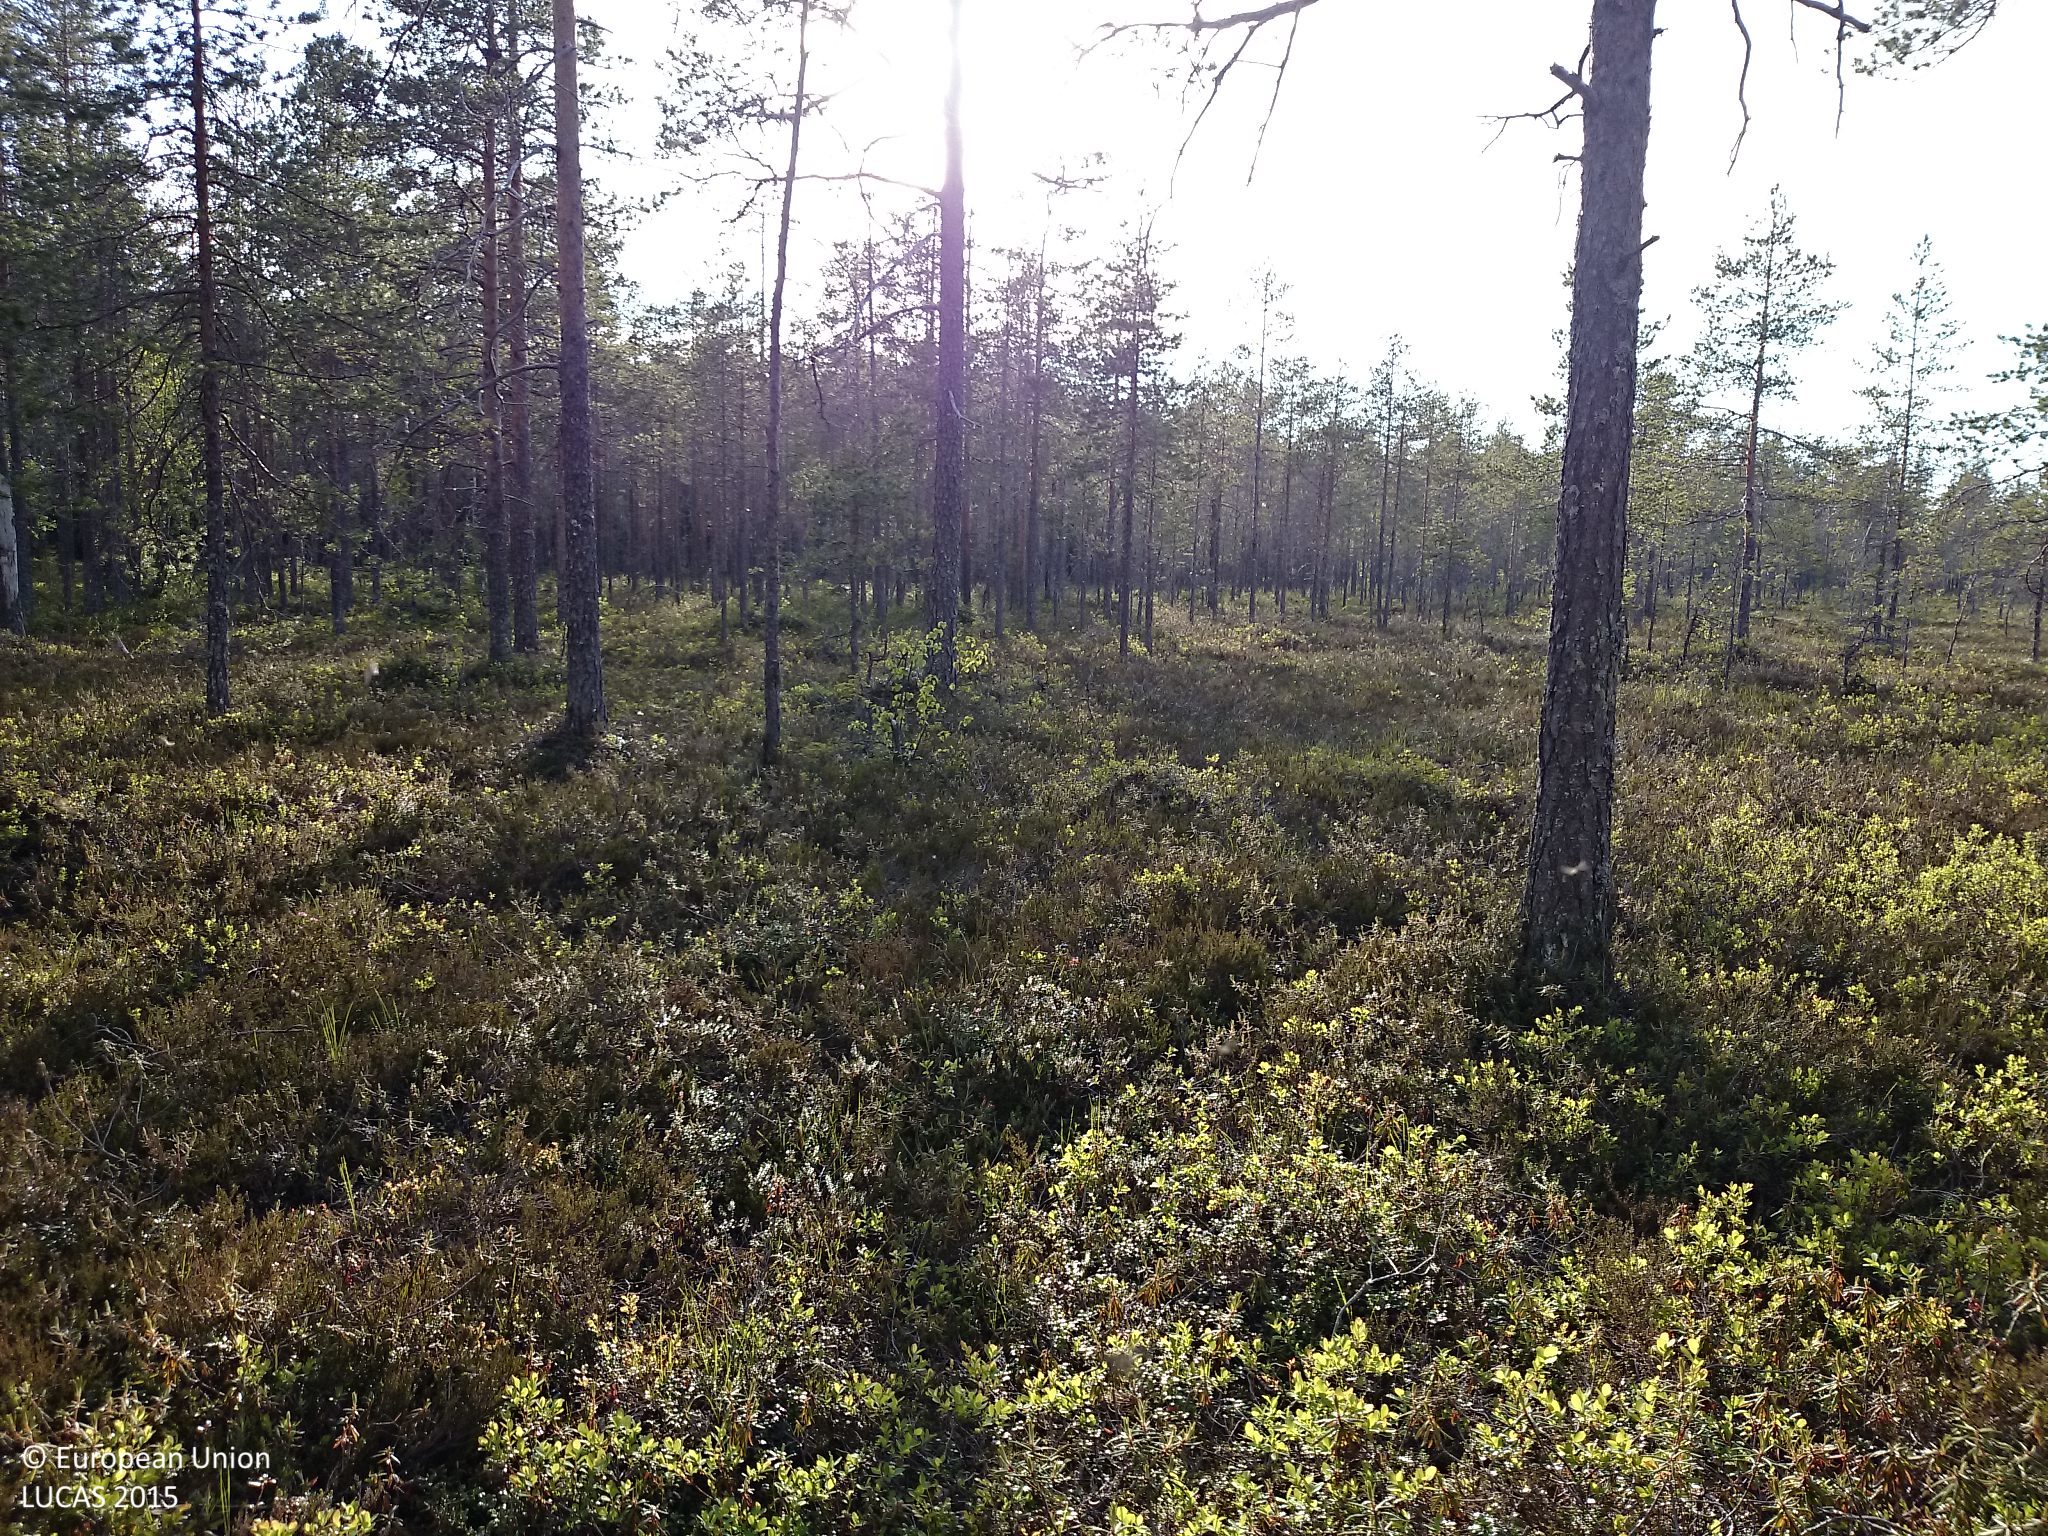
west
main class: Woodland
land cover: Pine dominated coniferous woodland
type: boreal forest
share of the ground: 50 - 75 %
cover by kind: coniferous forest trees 60 %, shrubs 40 %
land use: Forestry
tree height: > 5 m
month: June
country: SE
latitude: 64.0596
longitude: 20.6163
